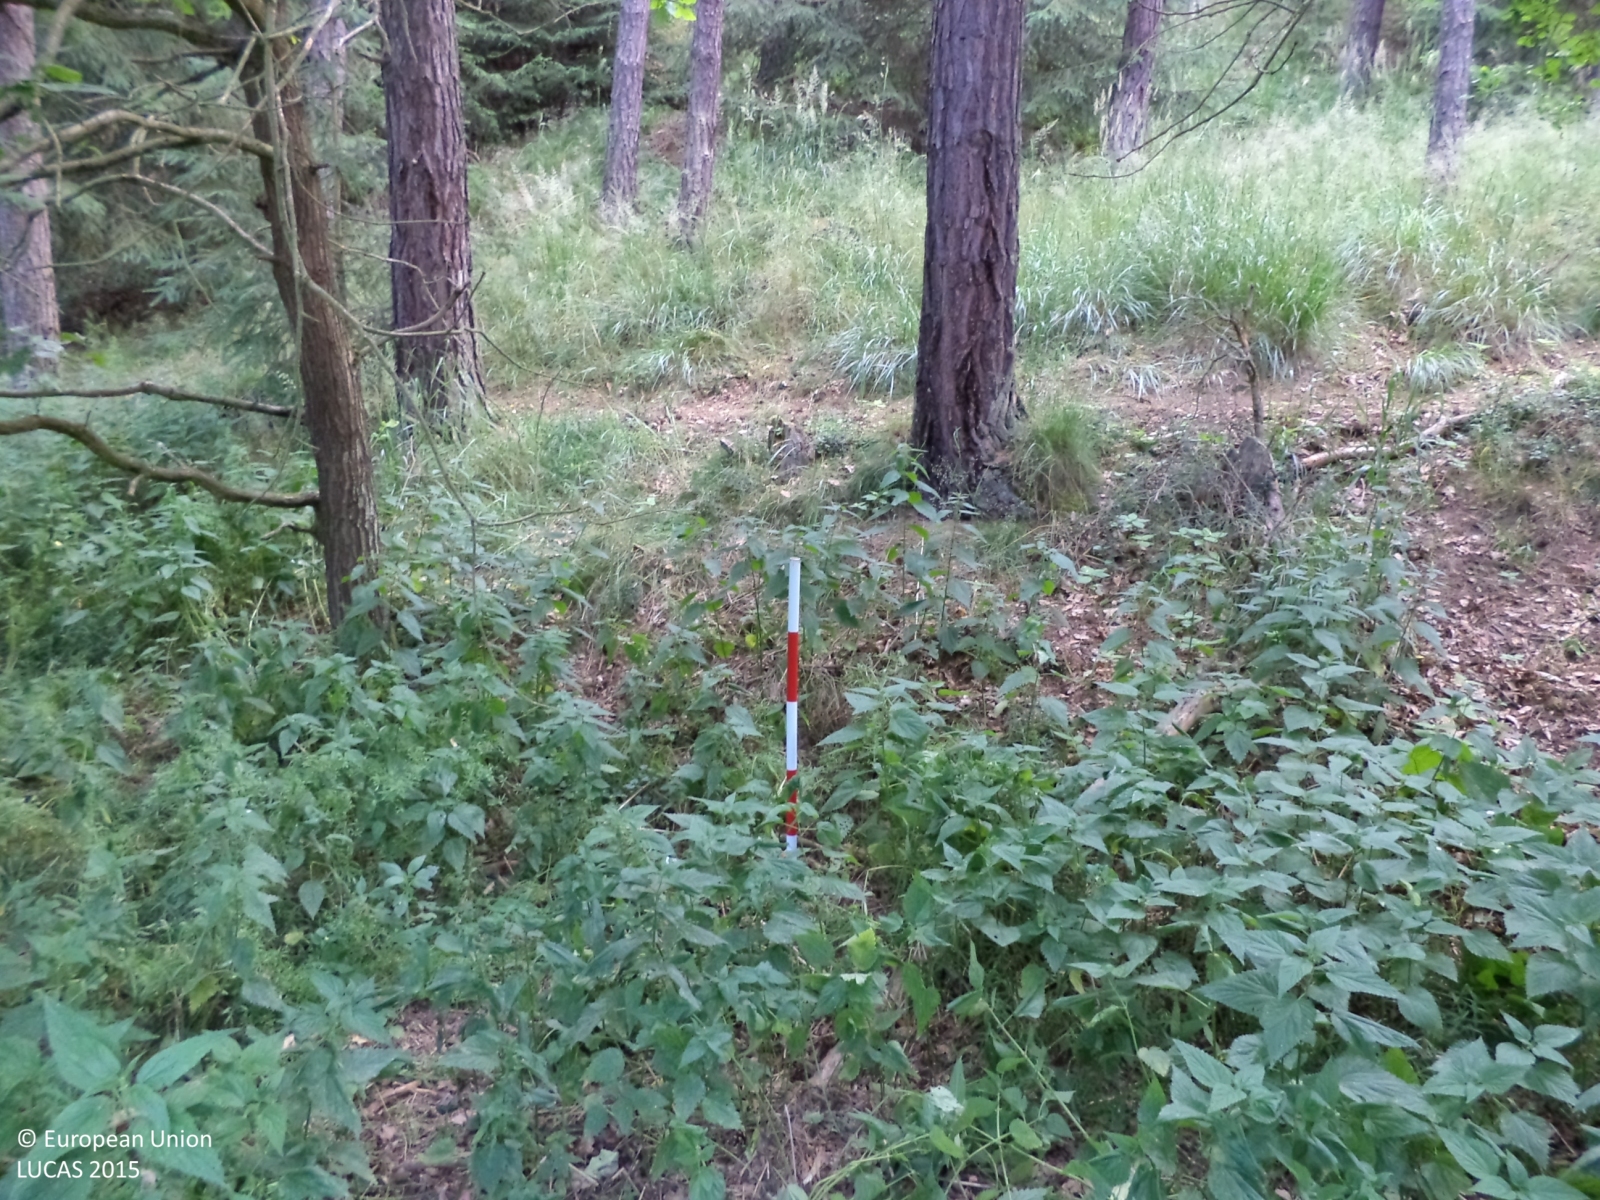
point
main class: Grassland
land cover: Grassland without tree/shrub cover
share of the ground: > 75 %
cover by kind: herbaceous plants 100 %
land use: Forestry
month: July
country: CZ
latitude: 49.3949
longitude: 14.4518
